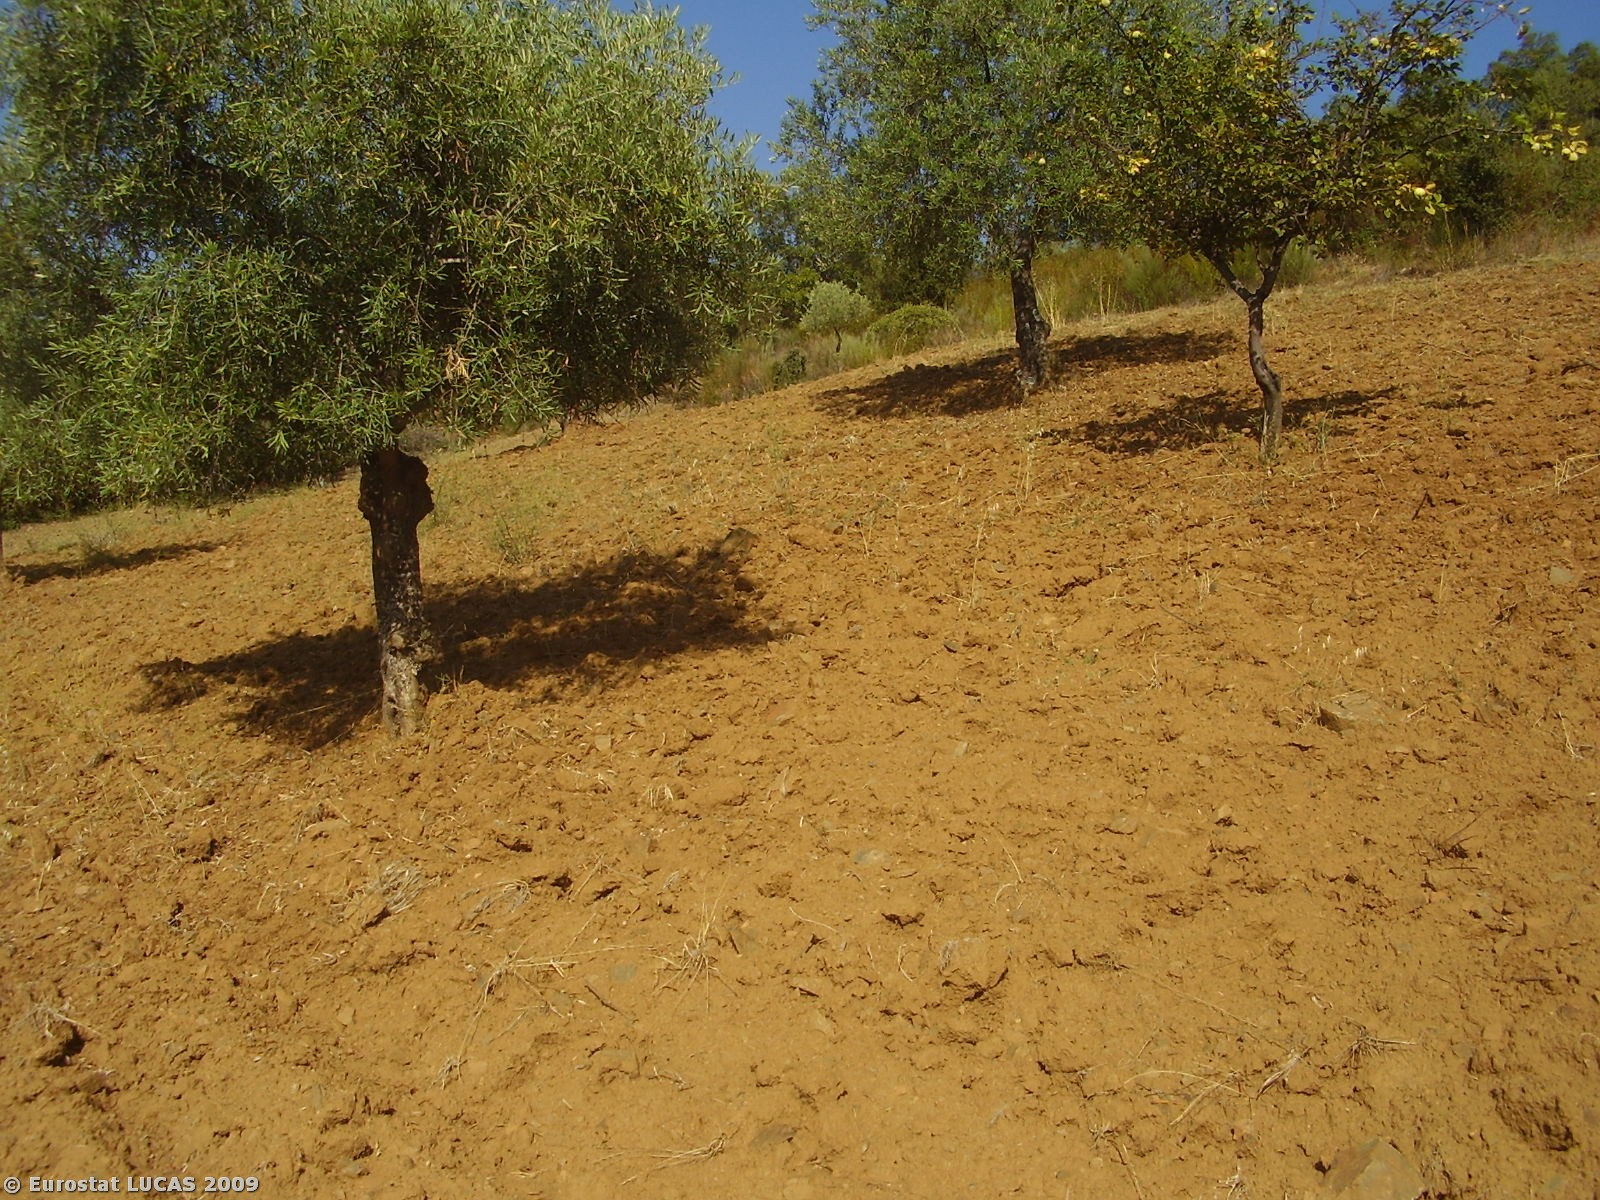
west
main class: Cropland
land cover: Olive groves
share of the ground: 10 - 25 %
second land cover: Bare land
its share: > 75 %
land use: Agriculture (excluding fallow land and kitchen gardens)
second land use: Fallow land
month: August
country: PT
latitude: 41.4014
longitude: -6.8187
